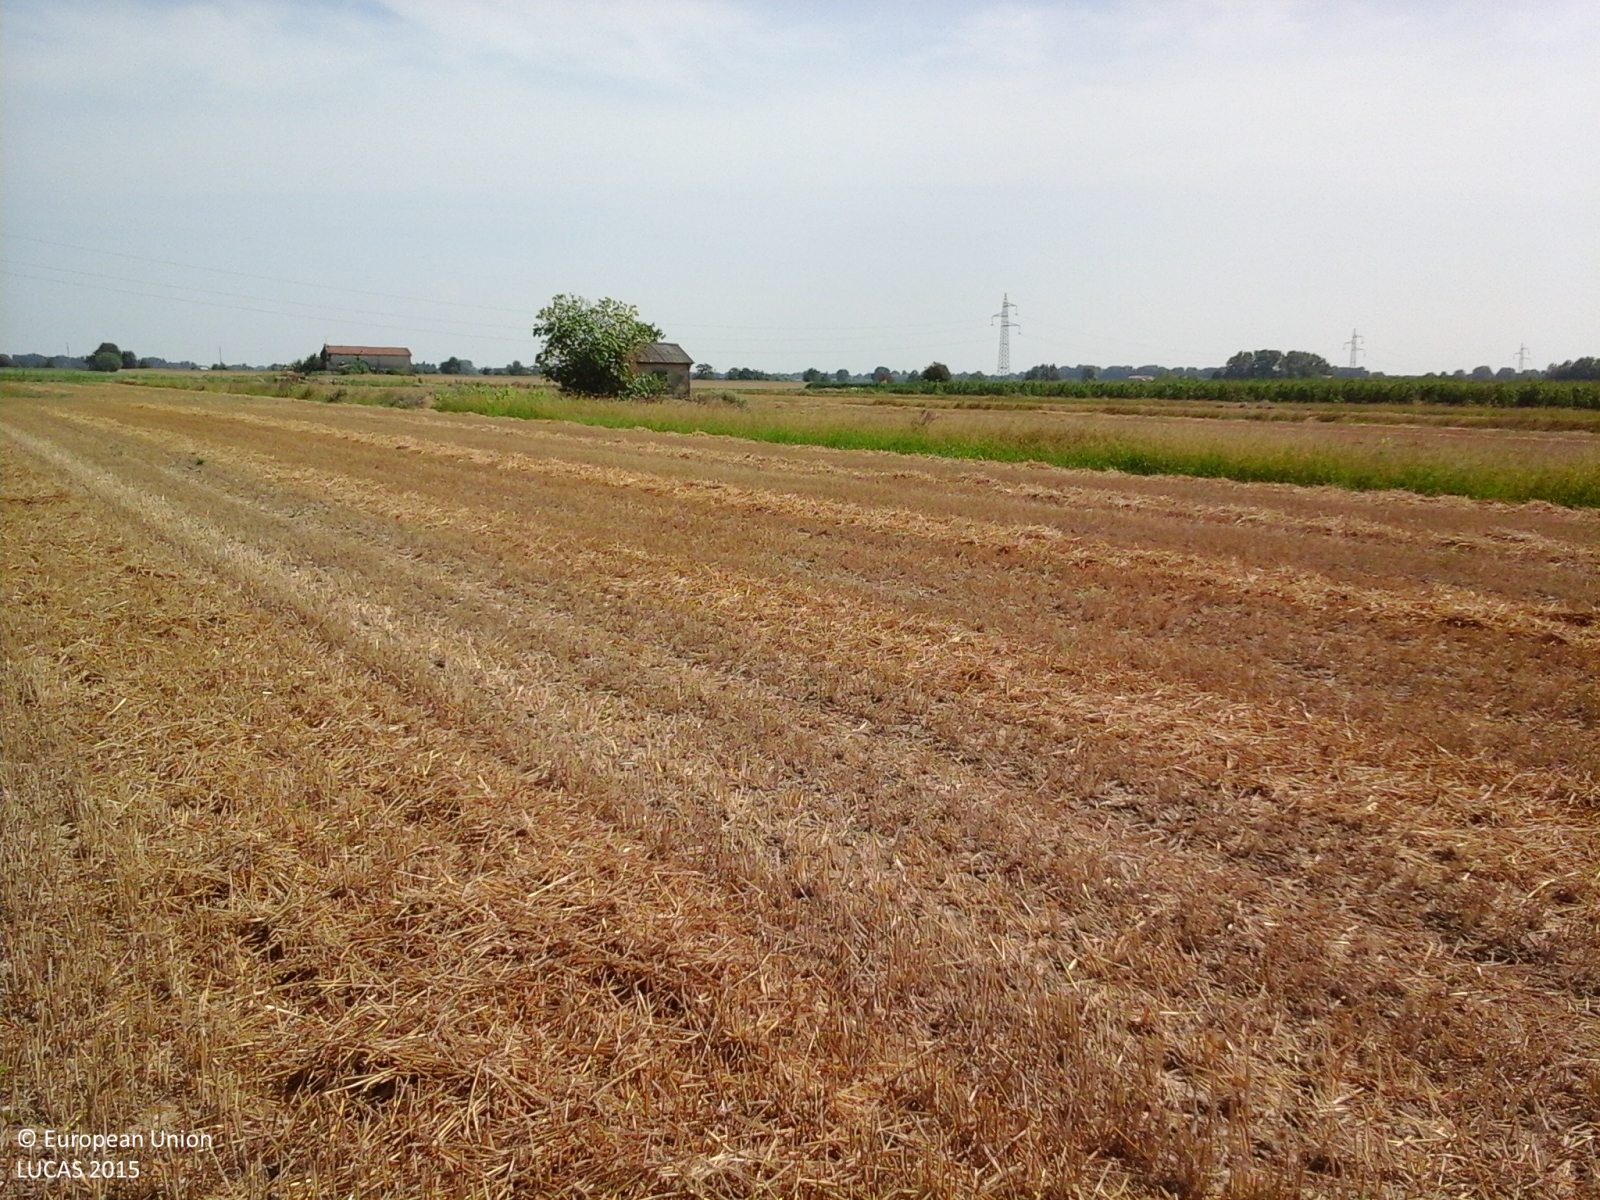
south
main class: Cropland
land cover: Common wheat
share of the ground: > 75 %
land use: Agriculture (excluding fallow land and kitchen gardens)
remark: Harvested field
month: July
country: IT
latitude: 44.7170
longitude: 11.6000
